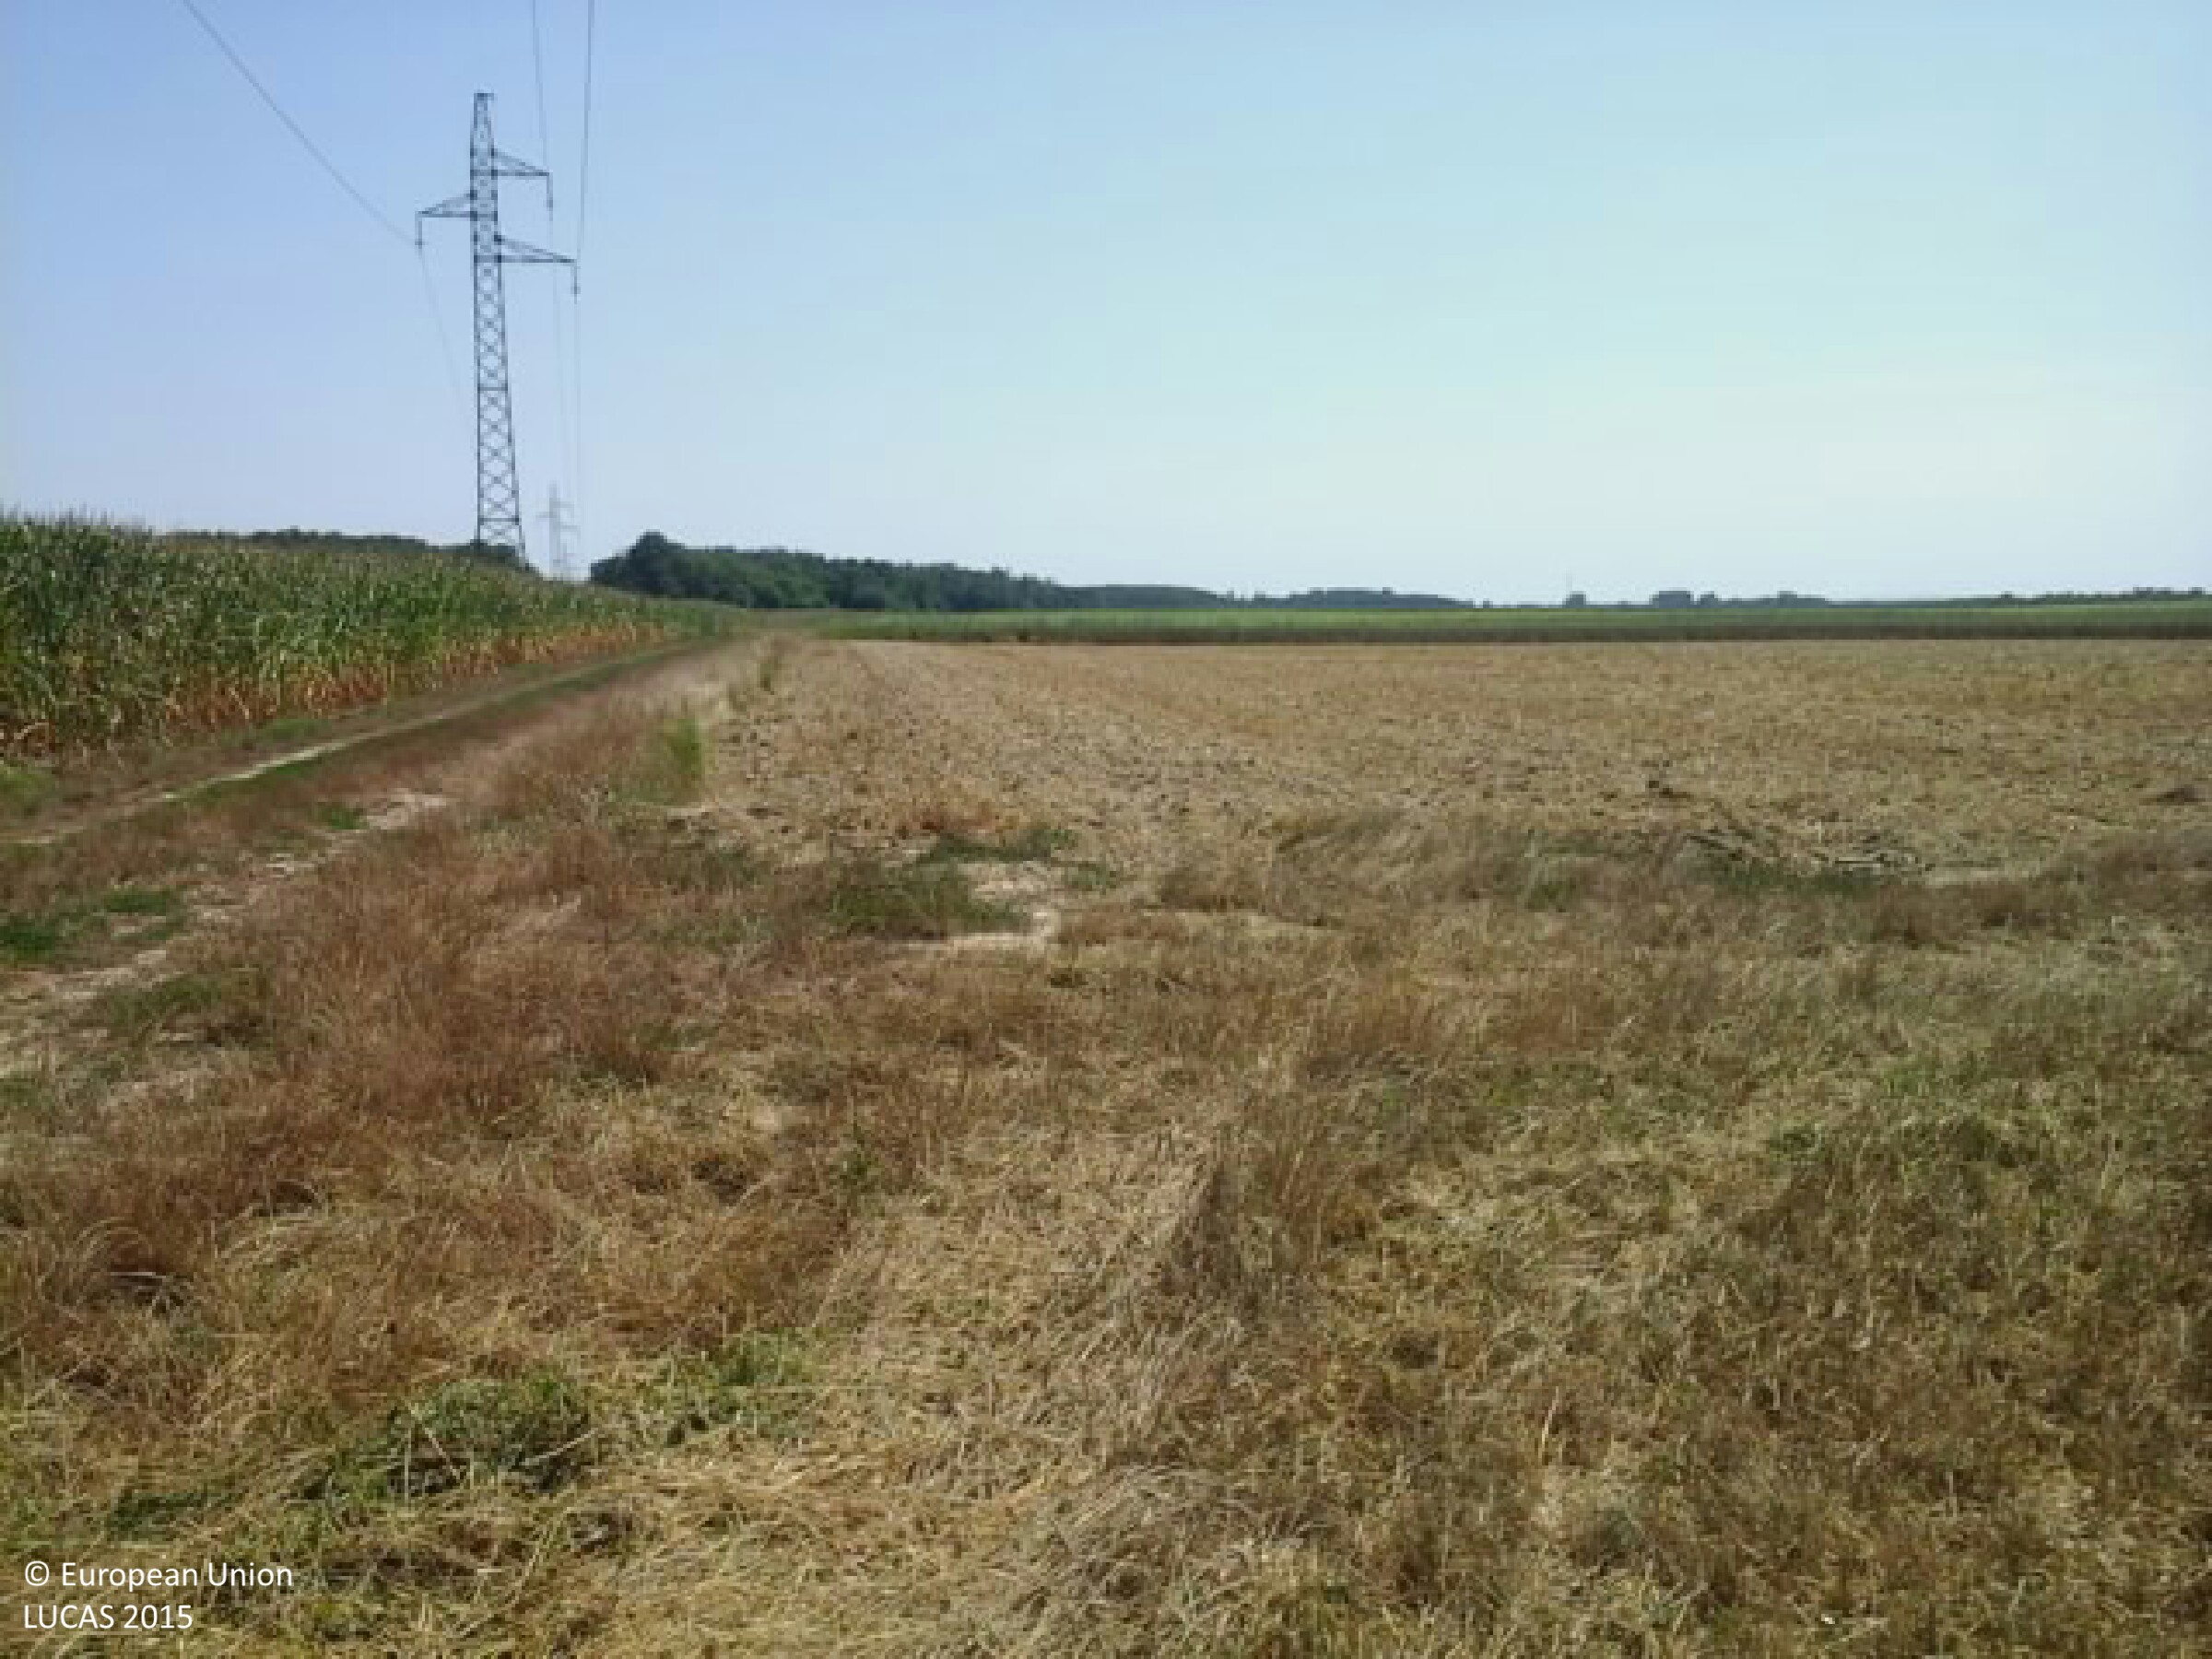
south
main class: Cropland
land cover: Common wheat
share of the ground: < 10 %
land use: Agriculture (excluding fallow land and kitchen gardens)
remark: Harvested field
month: July
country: HU
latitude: 46.2581
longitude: 17.1247
